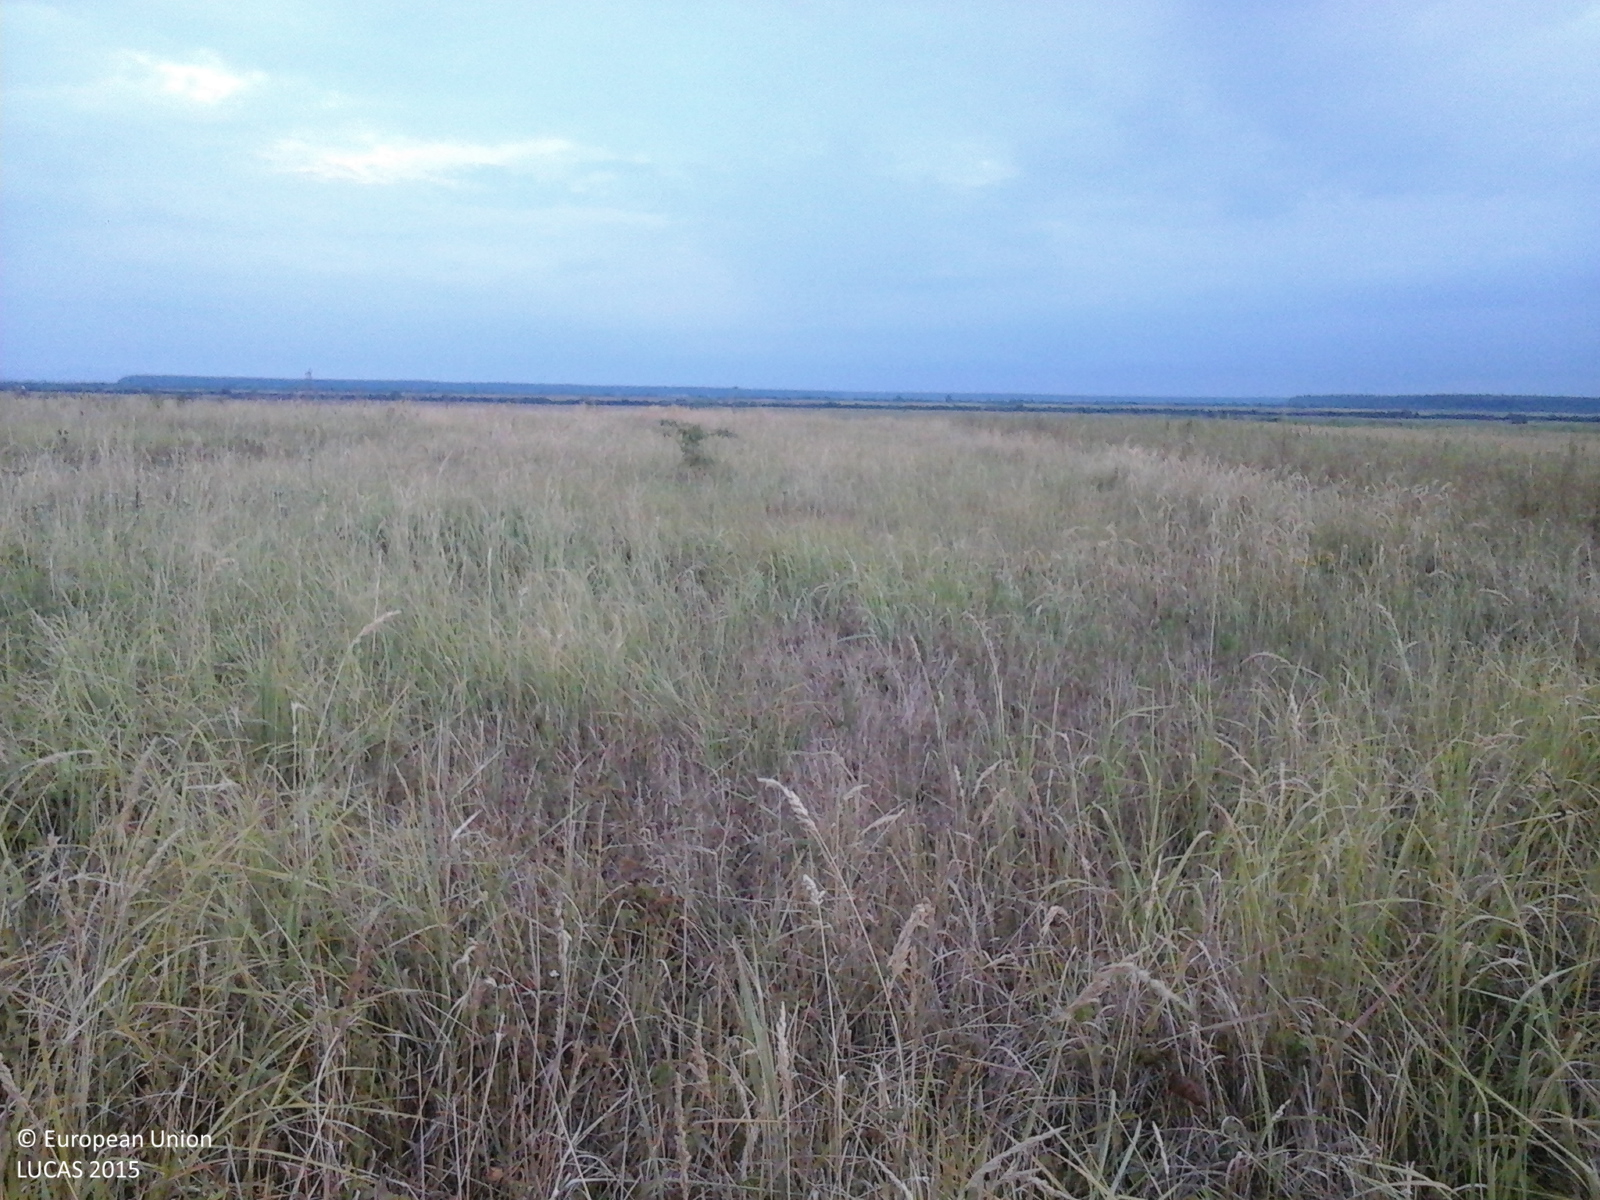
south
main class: Grassland
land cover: Spontaneously vegetated surfaces
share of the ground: > 75 %
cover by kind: herbaceous plants 100 %
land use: Fallow land
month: August
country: RO
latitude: 45.7961
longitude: 21.5490
